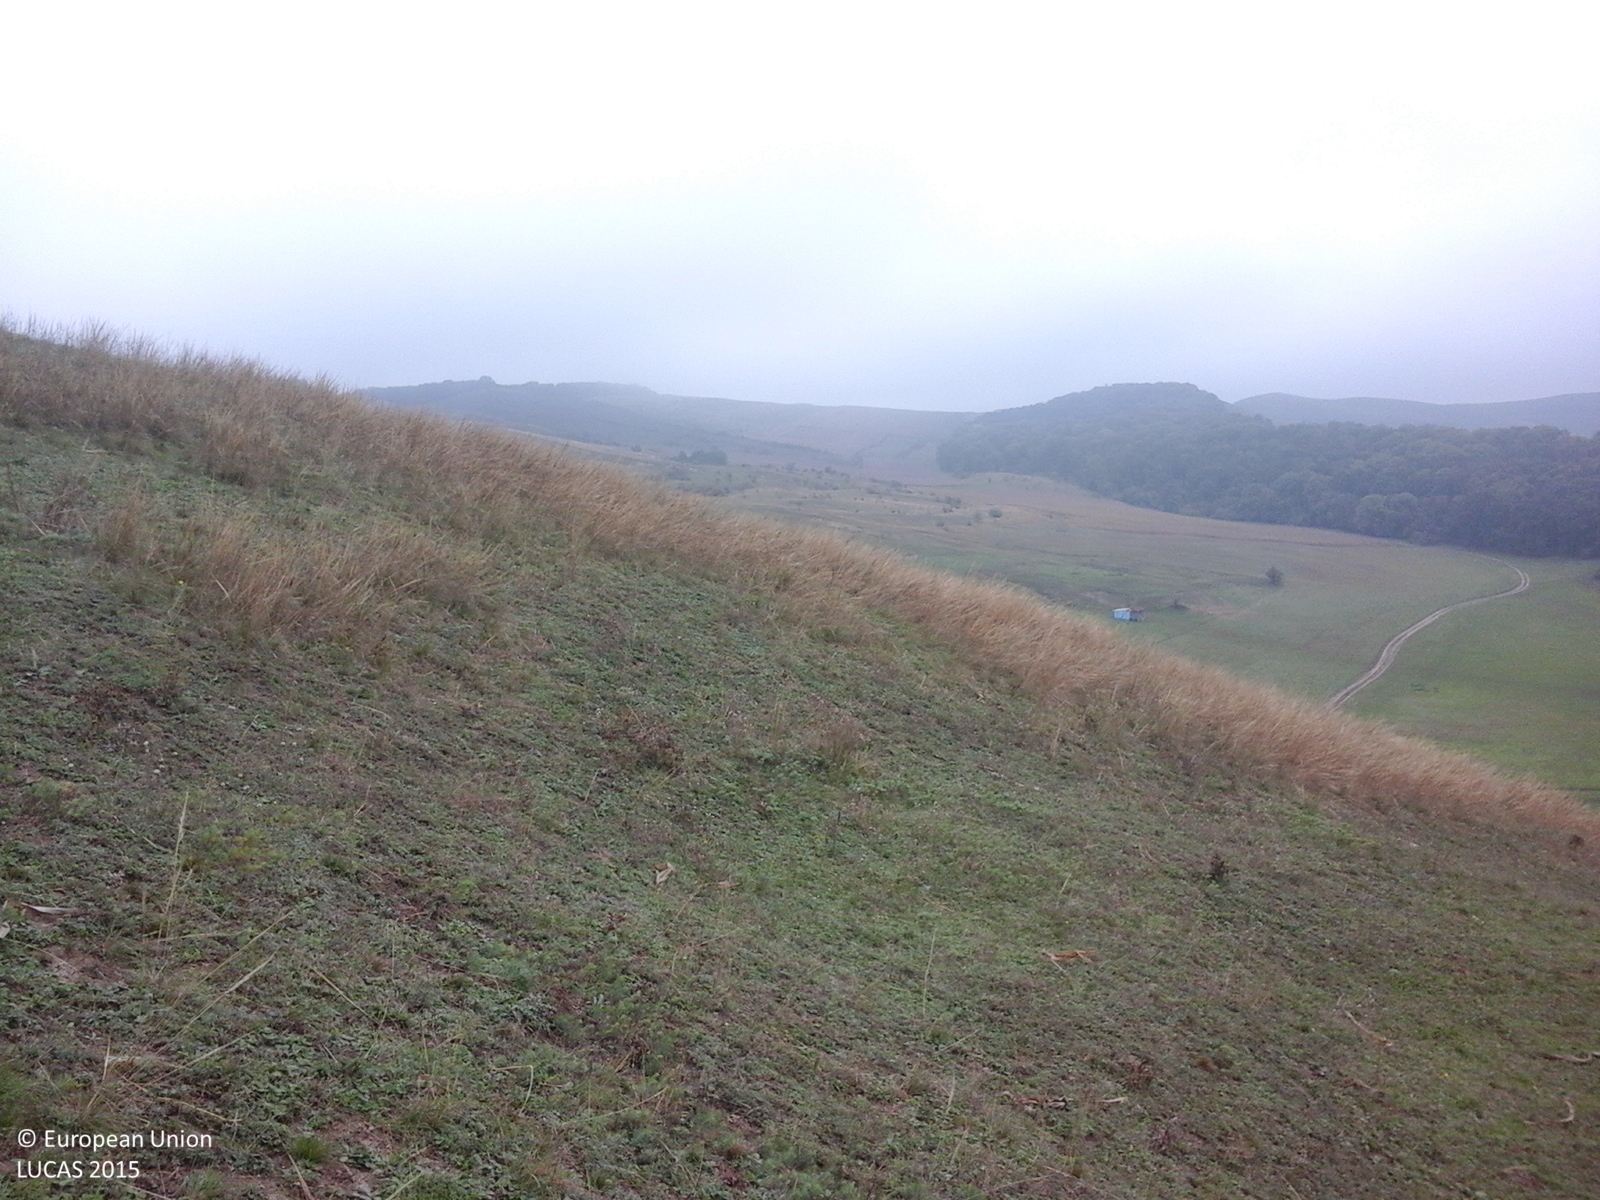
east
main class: Grassland
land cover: Grassland without tree/shrub cover
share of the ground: > 75 %
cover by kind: herbaceous plants 100 %
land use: Agriculture (excluding fallow land and kitchen gardens)
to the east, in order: Grassland without tree/shrub cover; Tracks; Grassland without tree/shrub cover; Ditches and canals; Grassland without tree/shrub cover; Tracks
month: October
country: RO
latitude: 46.6246
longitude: 23.9066
